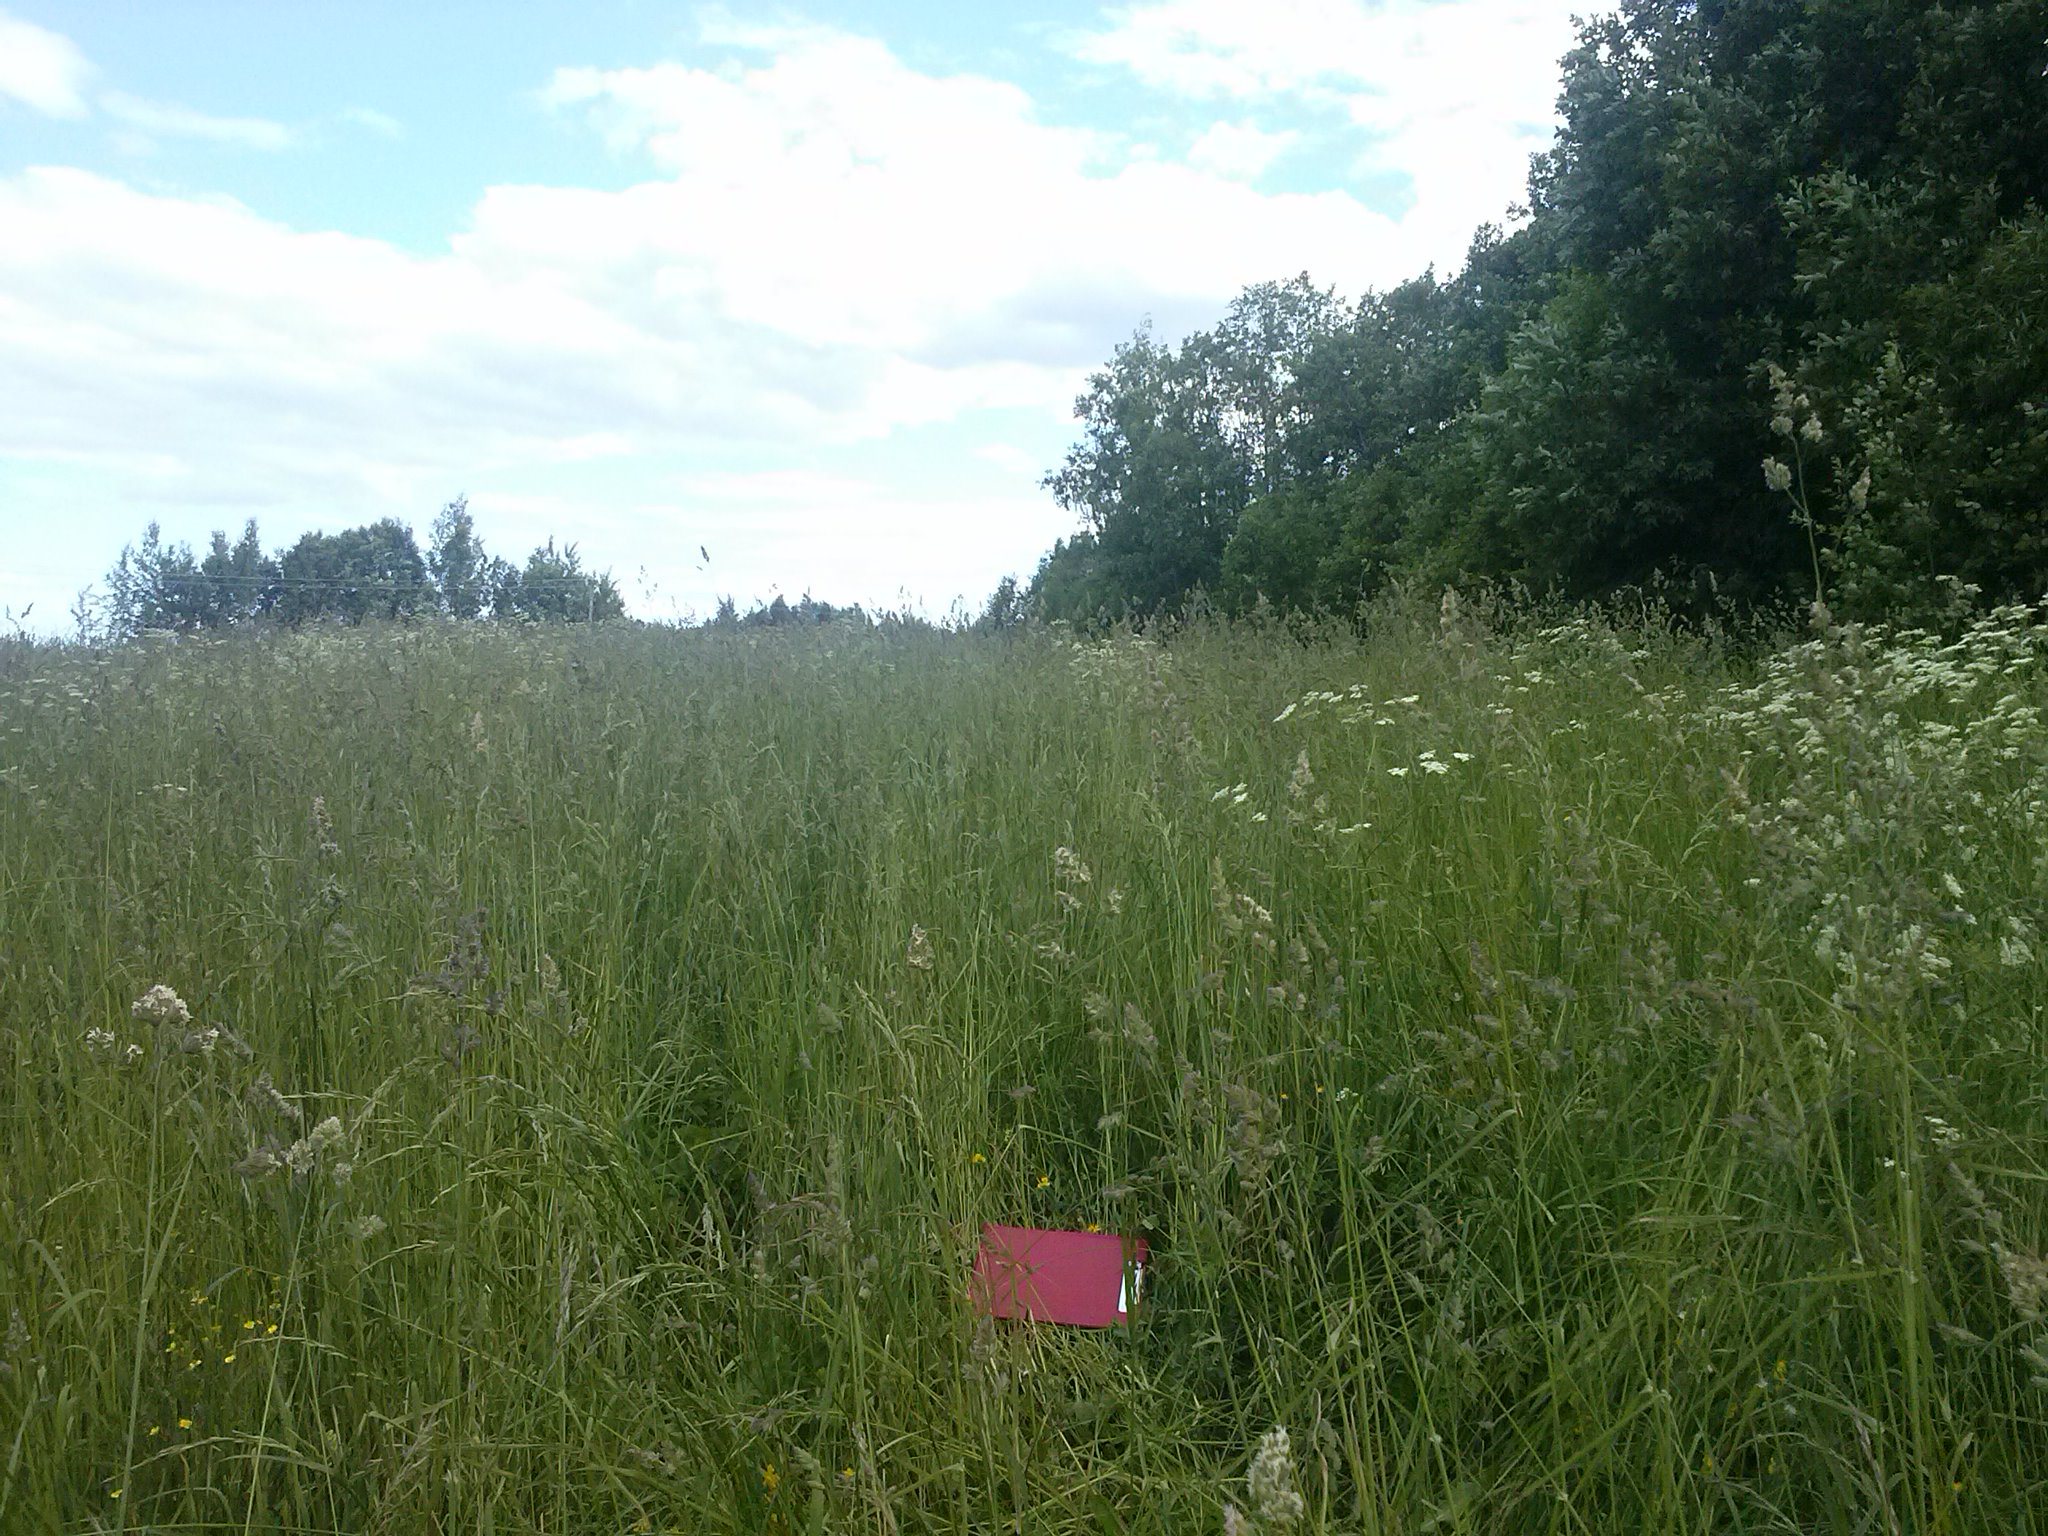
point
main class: Grassland
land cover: Grassland without tree/shrub cover
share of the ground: > 75 %
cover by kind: herbaceous plants 100 %
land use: Agriculture (excluding fallow land and kitchen gardens)
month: June
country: LV
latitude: 56.5003
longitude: 27.7827
